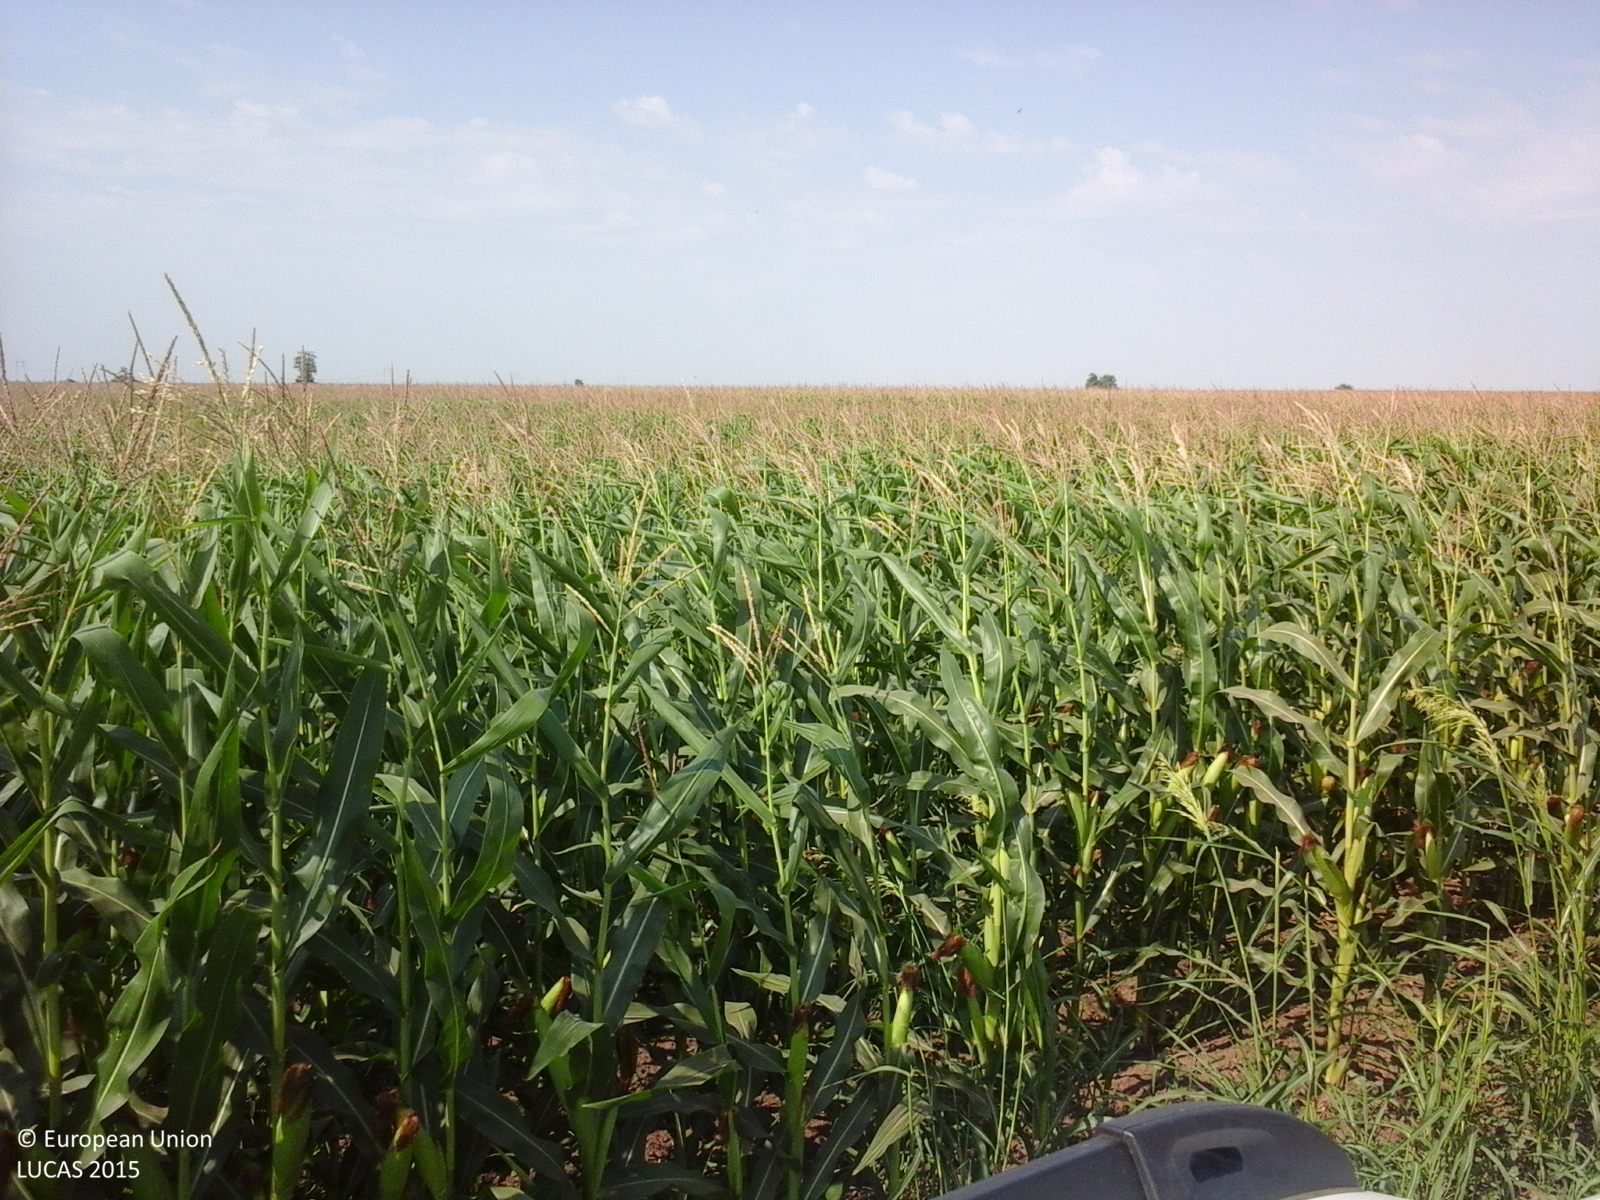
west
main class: Cropland
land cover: Maize
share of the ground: > 75 %
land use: Agriculture (excluding fallow land and kitchen gardens)
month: July
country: RO
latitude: 44.6464
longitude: 27.2212
